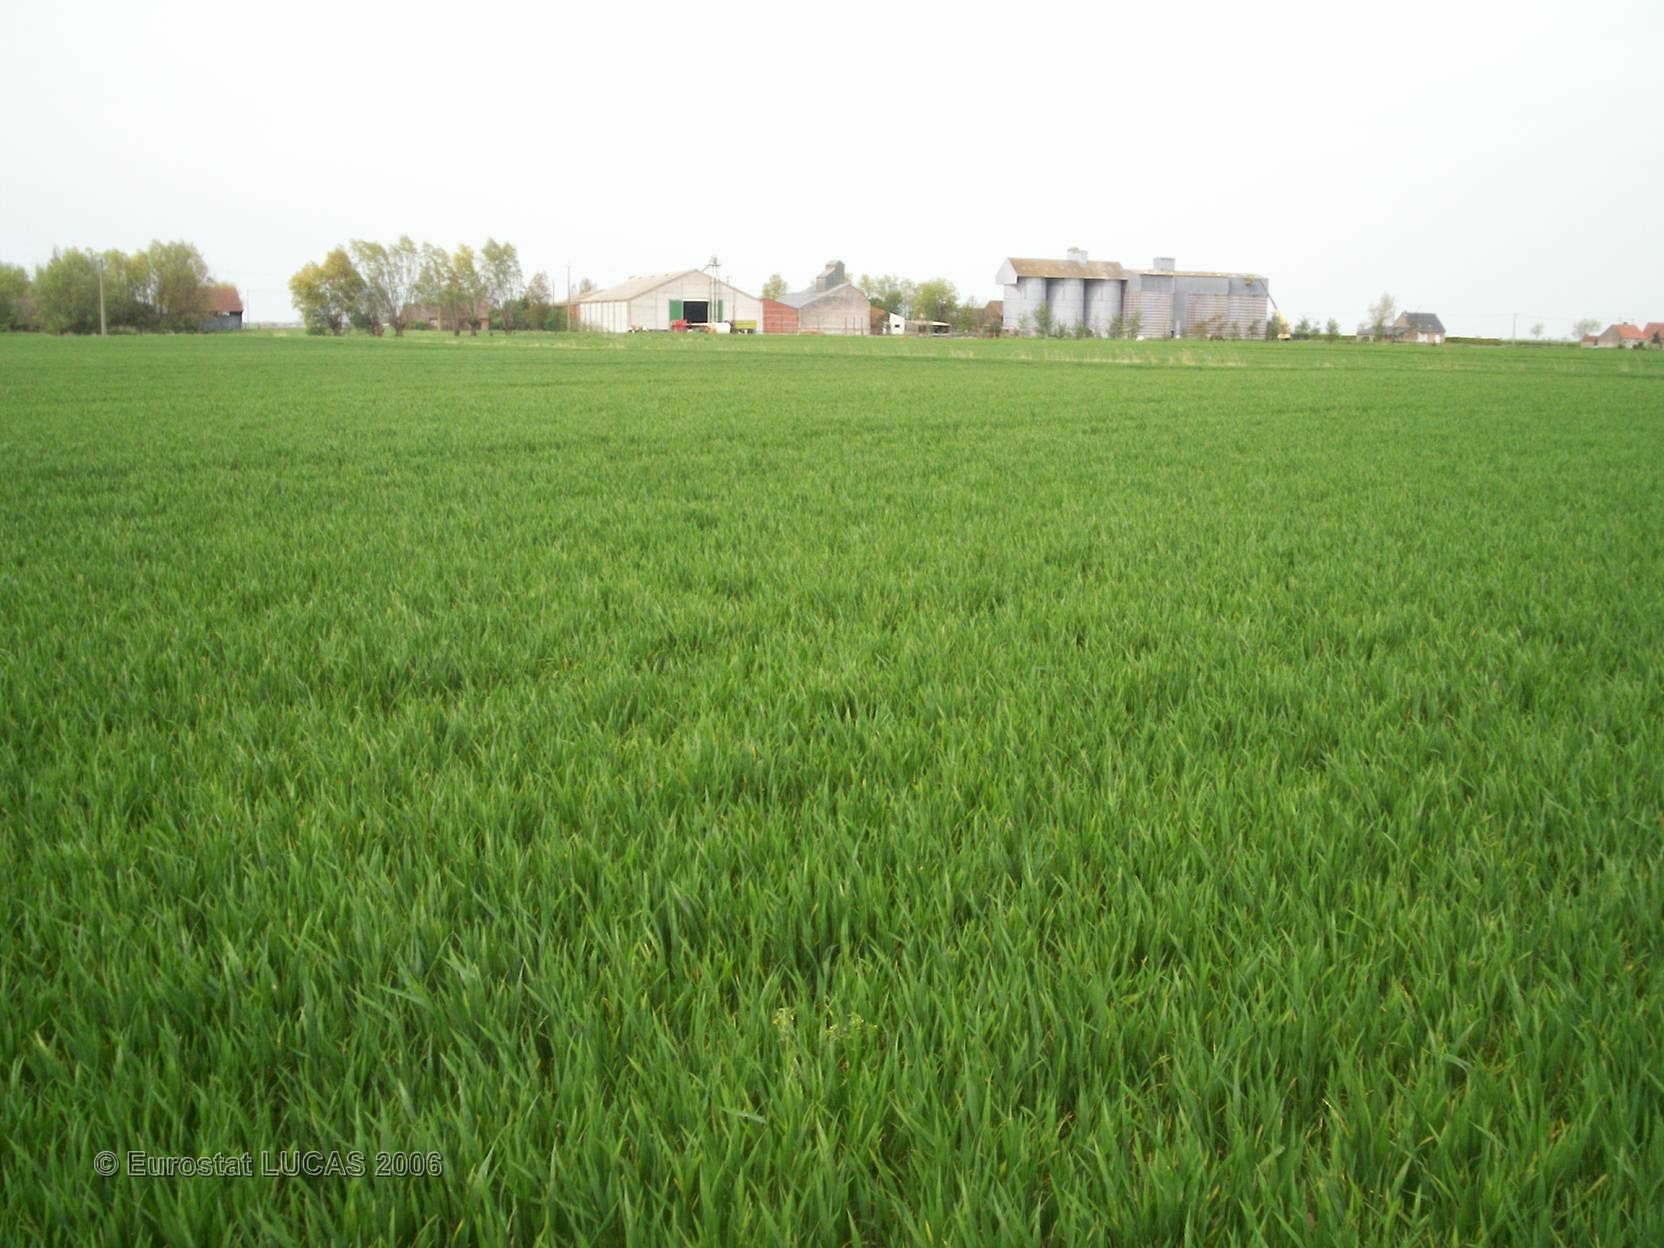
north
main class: Cropland
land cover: Common wheat
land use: Agriculture (excluding fallow land and kitchen gardens)
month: May
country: FR
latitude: 50.9832
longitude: 2.4802
